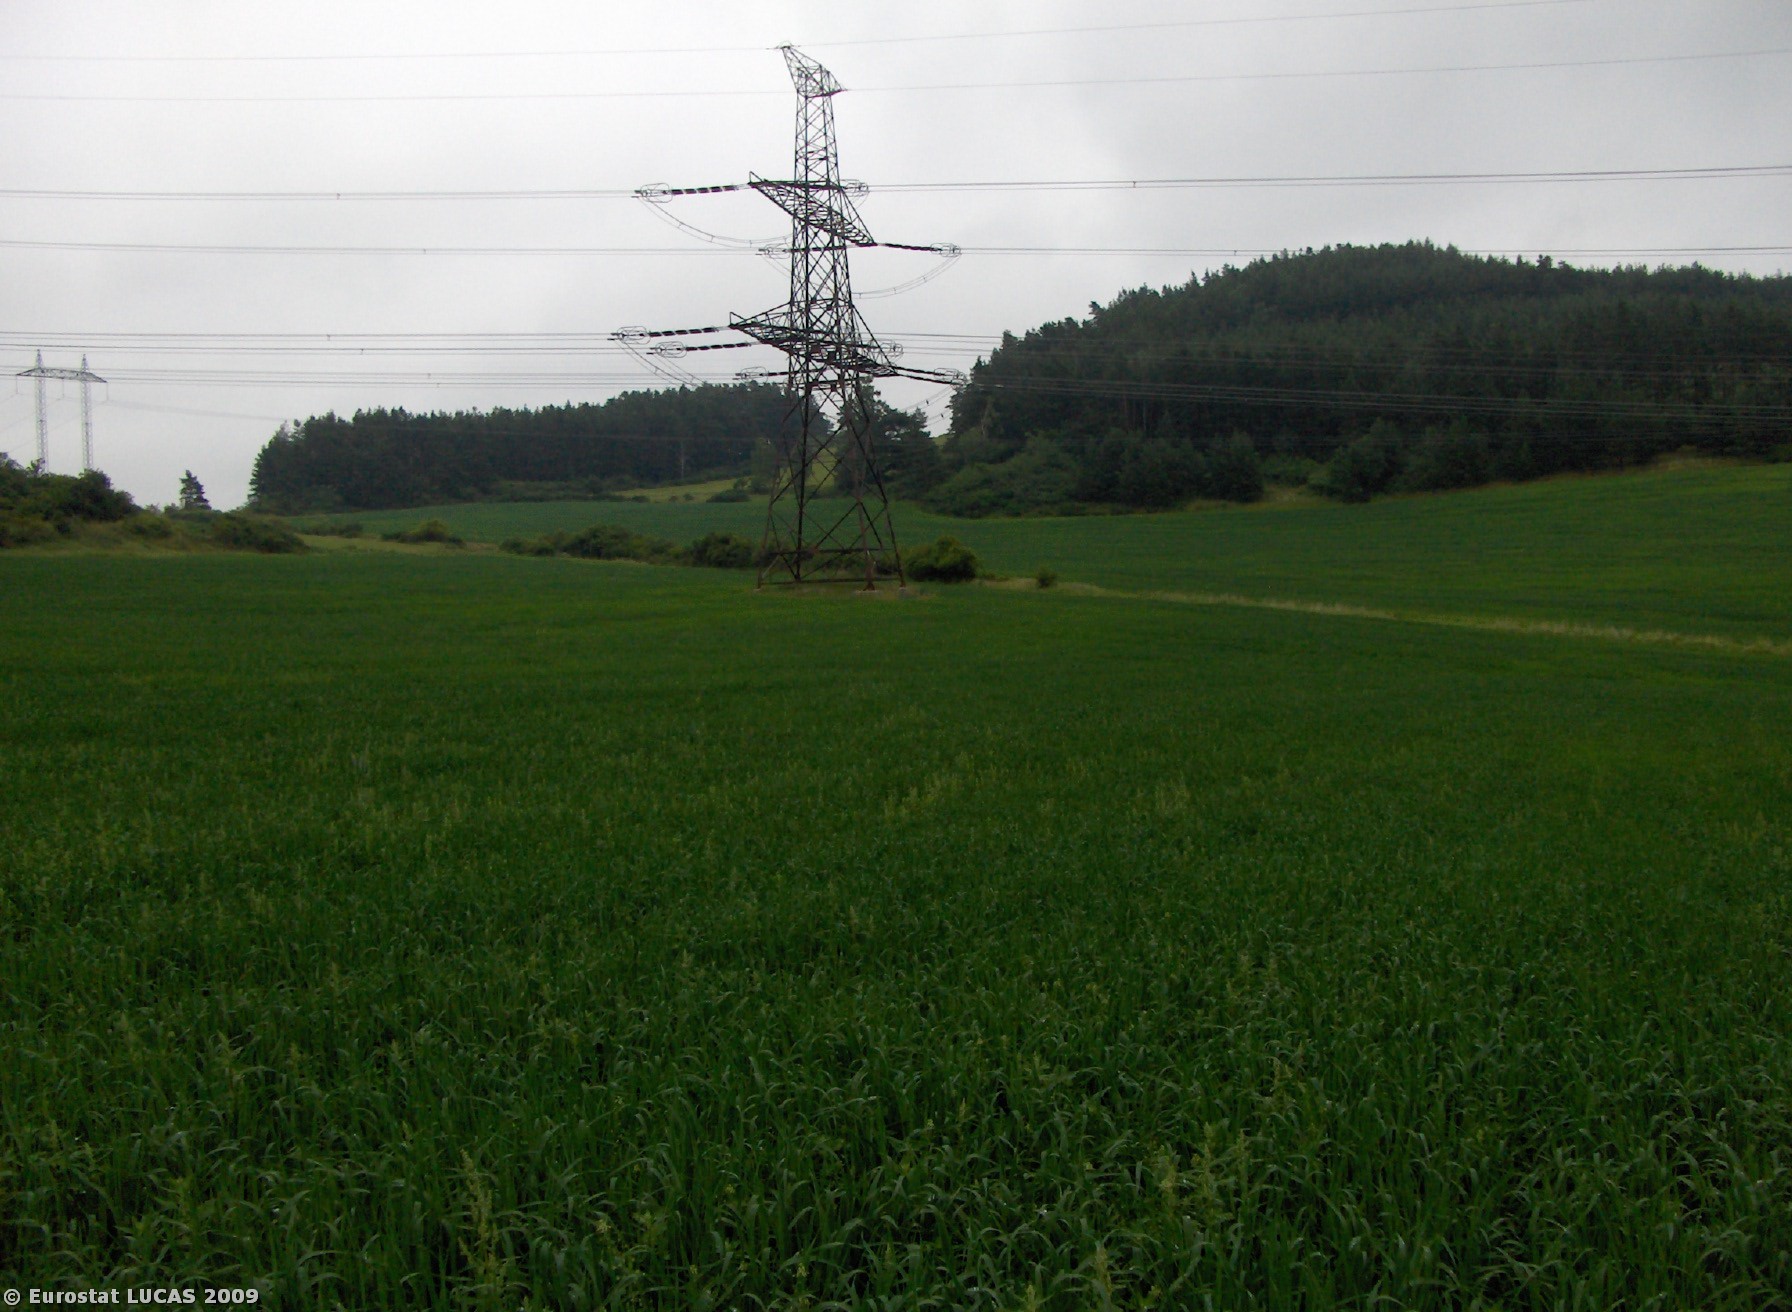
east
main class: Cropland
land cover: Oats
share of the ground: > 75 %
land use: Agriculture (excluding fallow land and kitchen gardens)
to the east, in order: Oats; Electric lines; Oats; Tracks; Shrubland without tree cover; Oats
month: June
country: CZ
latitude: 49.6747
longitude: 14.1999
